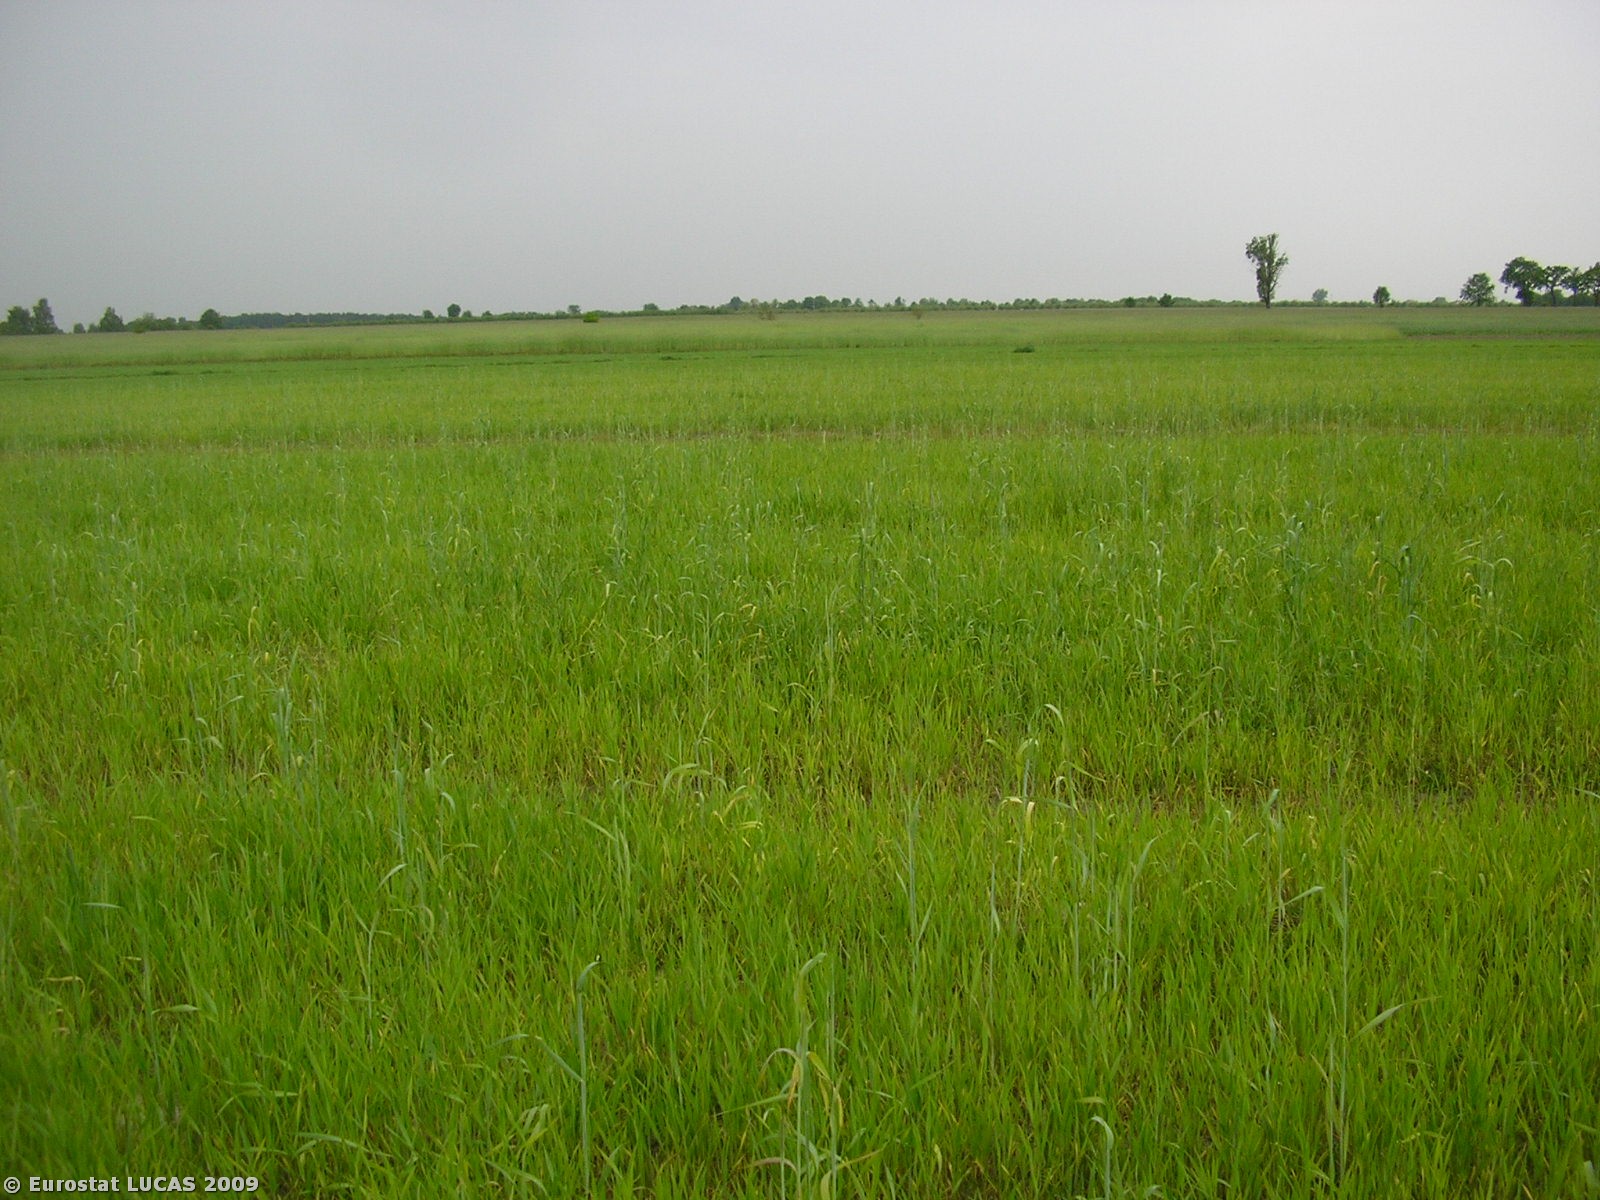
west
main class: Cropland
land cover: Triticale
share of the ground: 50 - 75 %
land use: Agriculture (excluding fallow land and kitchen gardens)
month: May
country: PL
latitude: 51.3754
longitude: 19.9885
